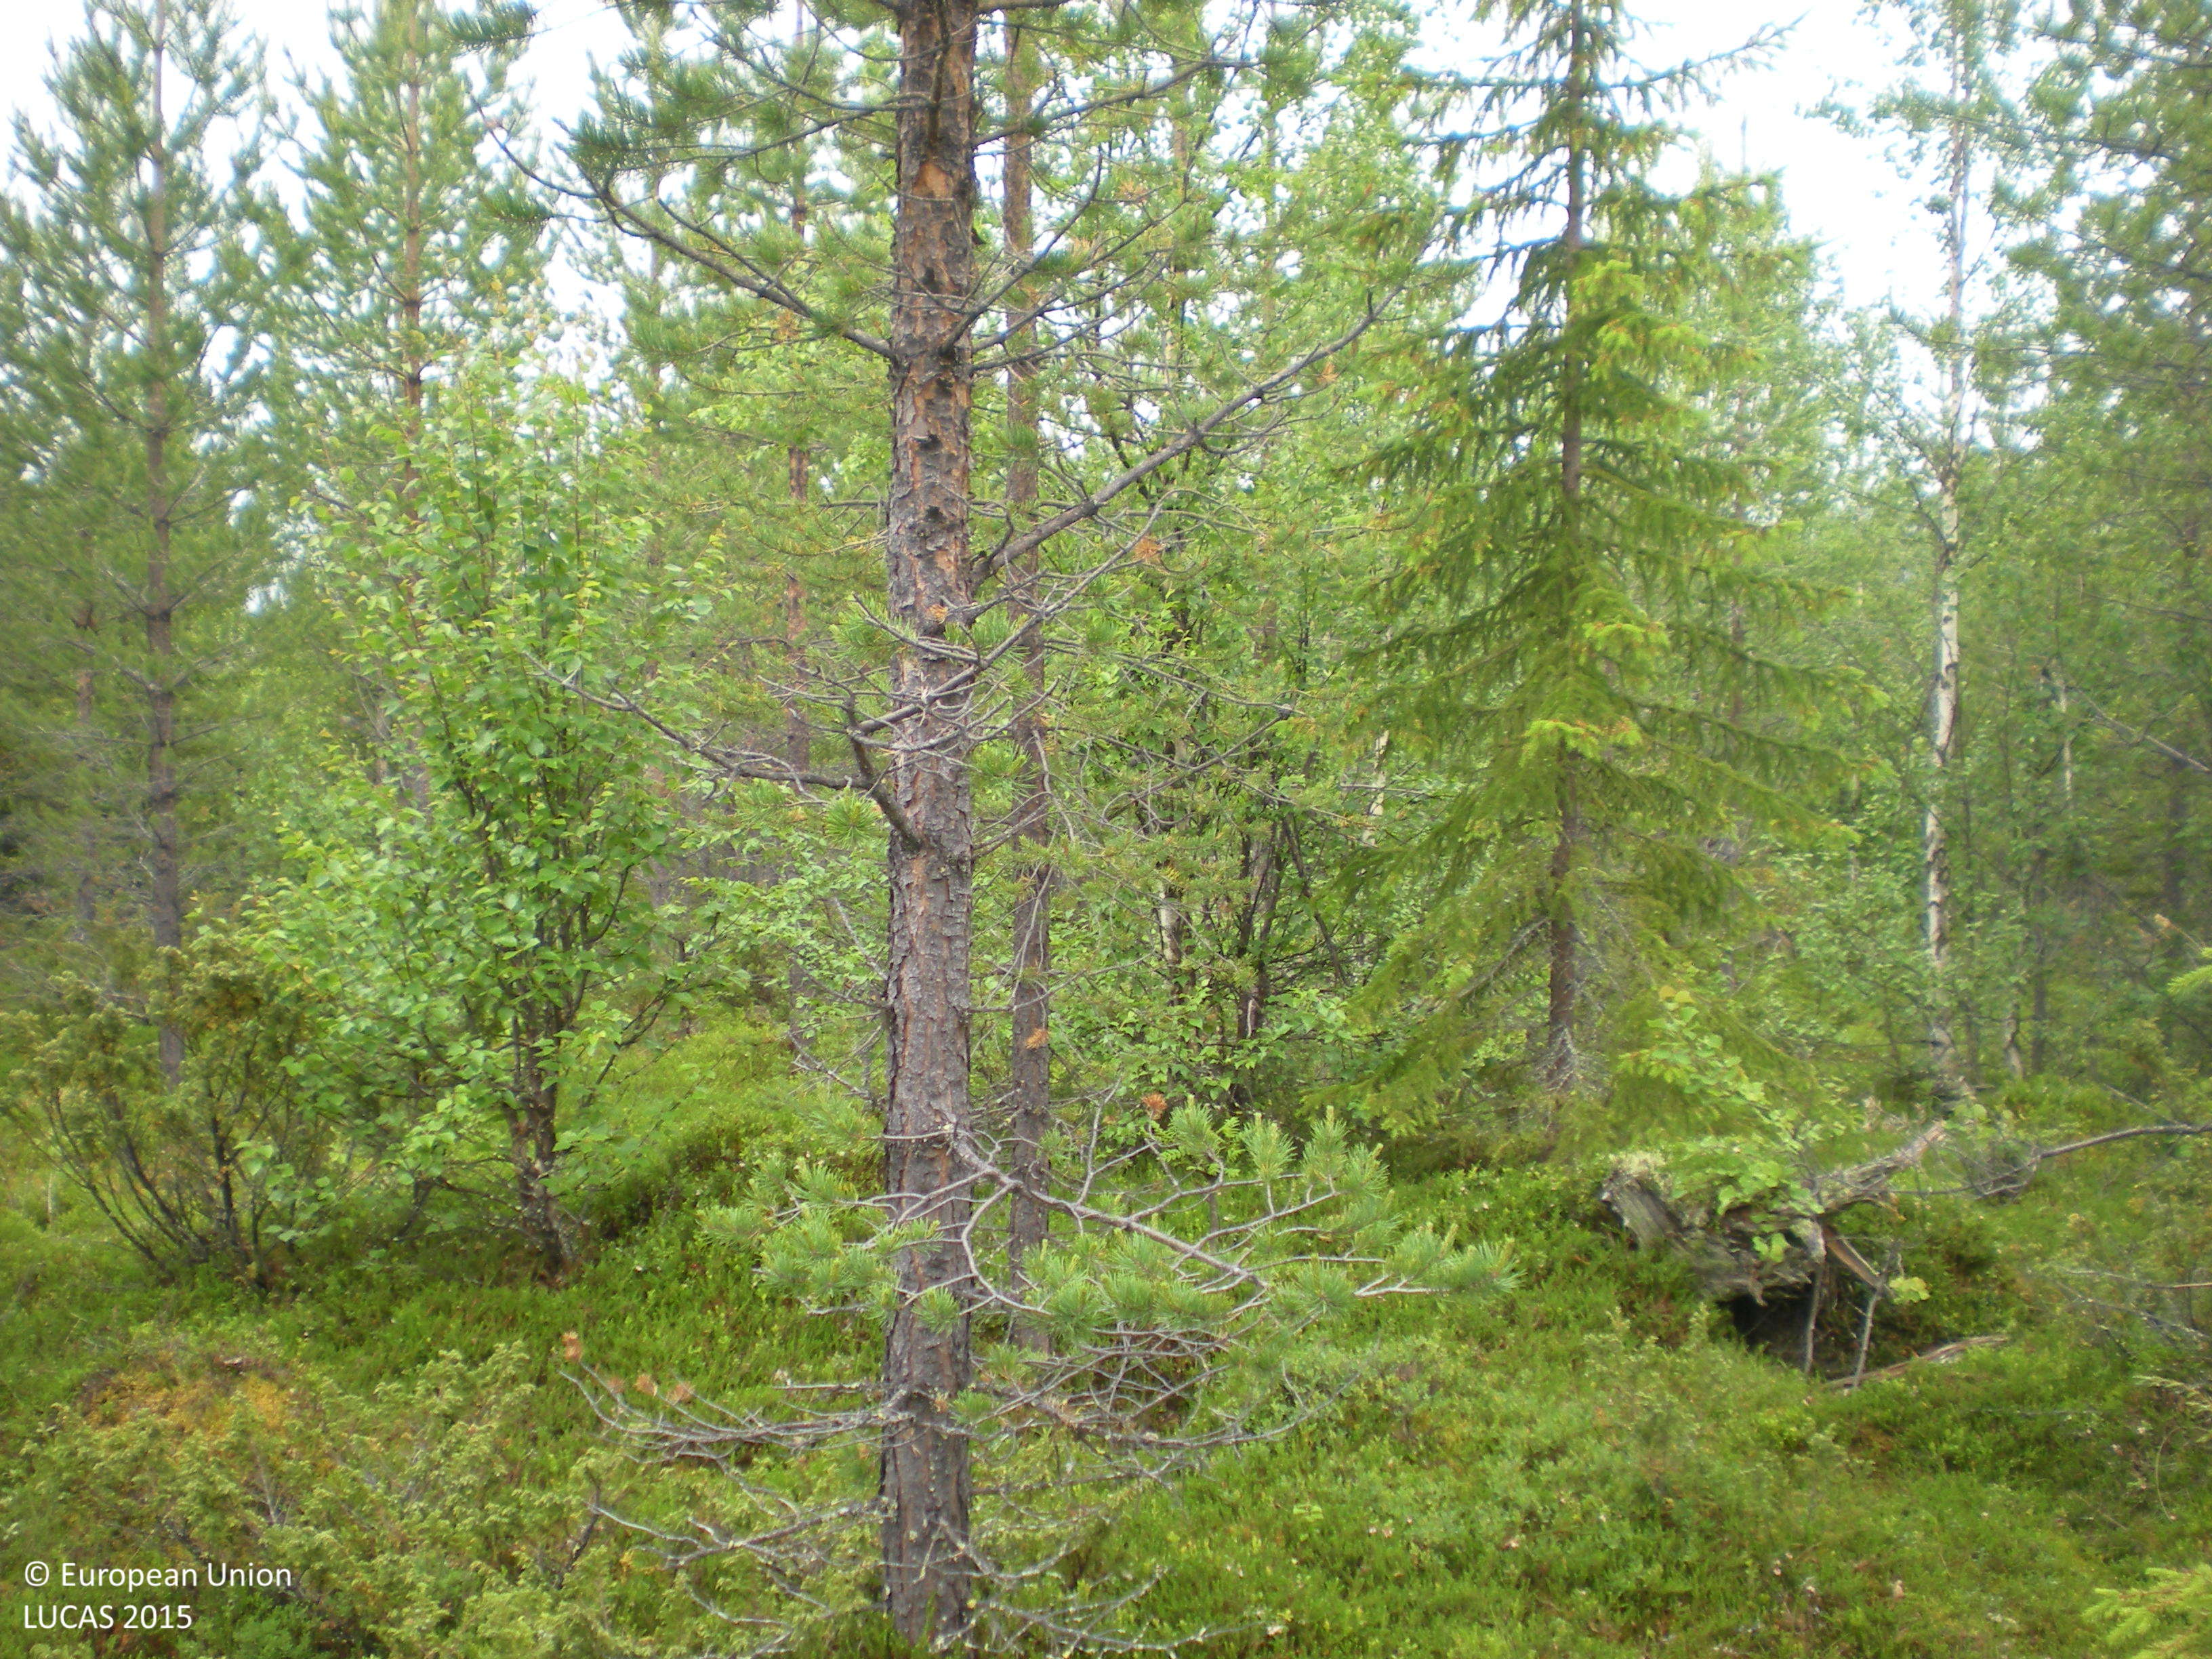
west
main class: Woodland
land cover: Pine dominated mixed woodland
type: boreal forest
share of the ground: 50 - 75 %
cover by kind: coniferous forest trees 45 %, shrubs 30 %, broadleaved forest trees 15 %, lichens and mosses 10 %
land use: Forestry
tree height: > 5 m
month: July
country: SE
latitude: 65.7566
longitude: 17.2697
